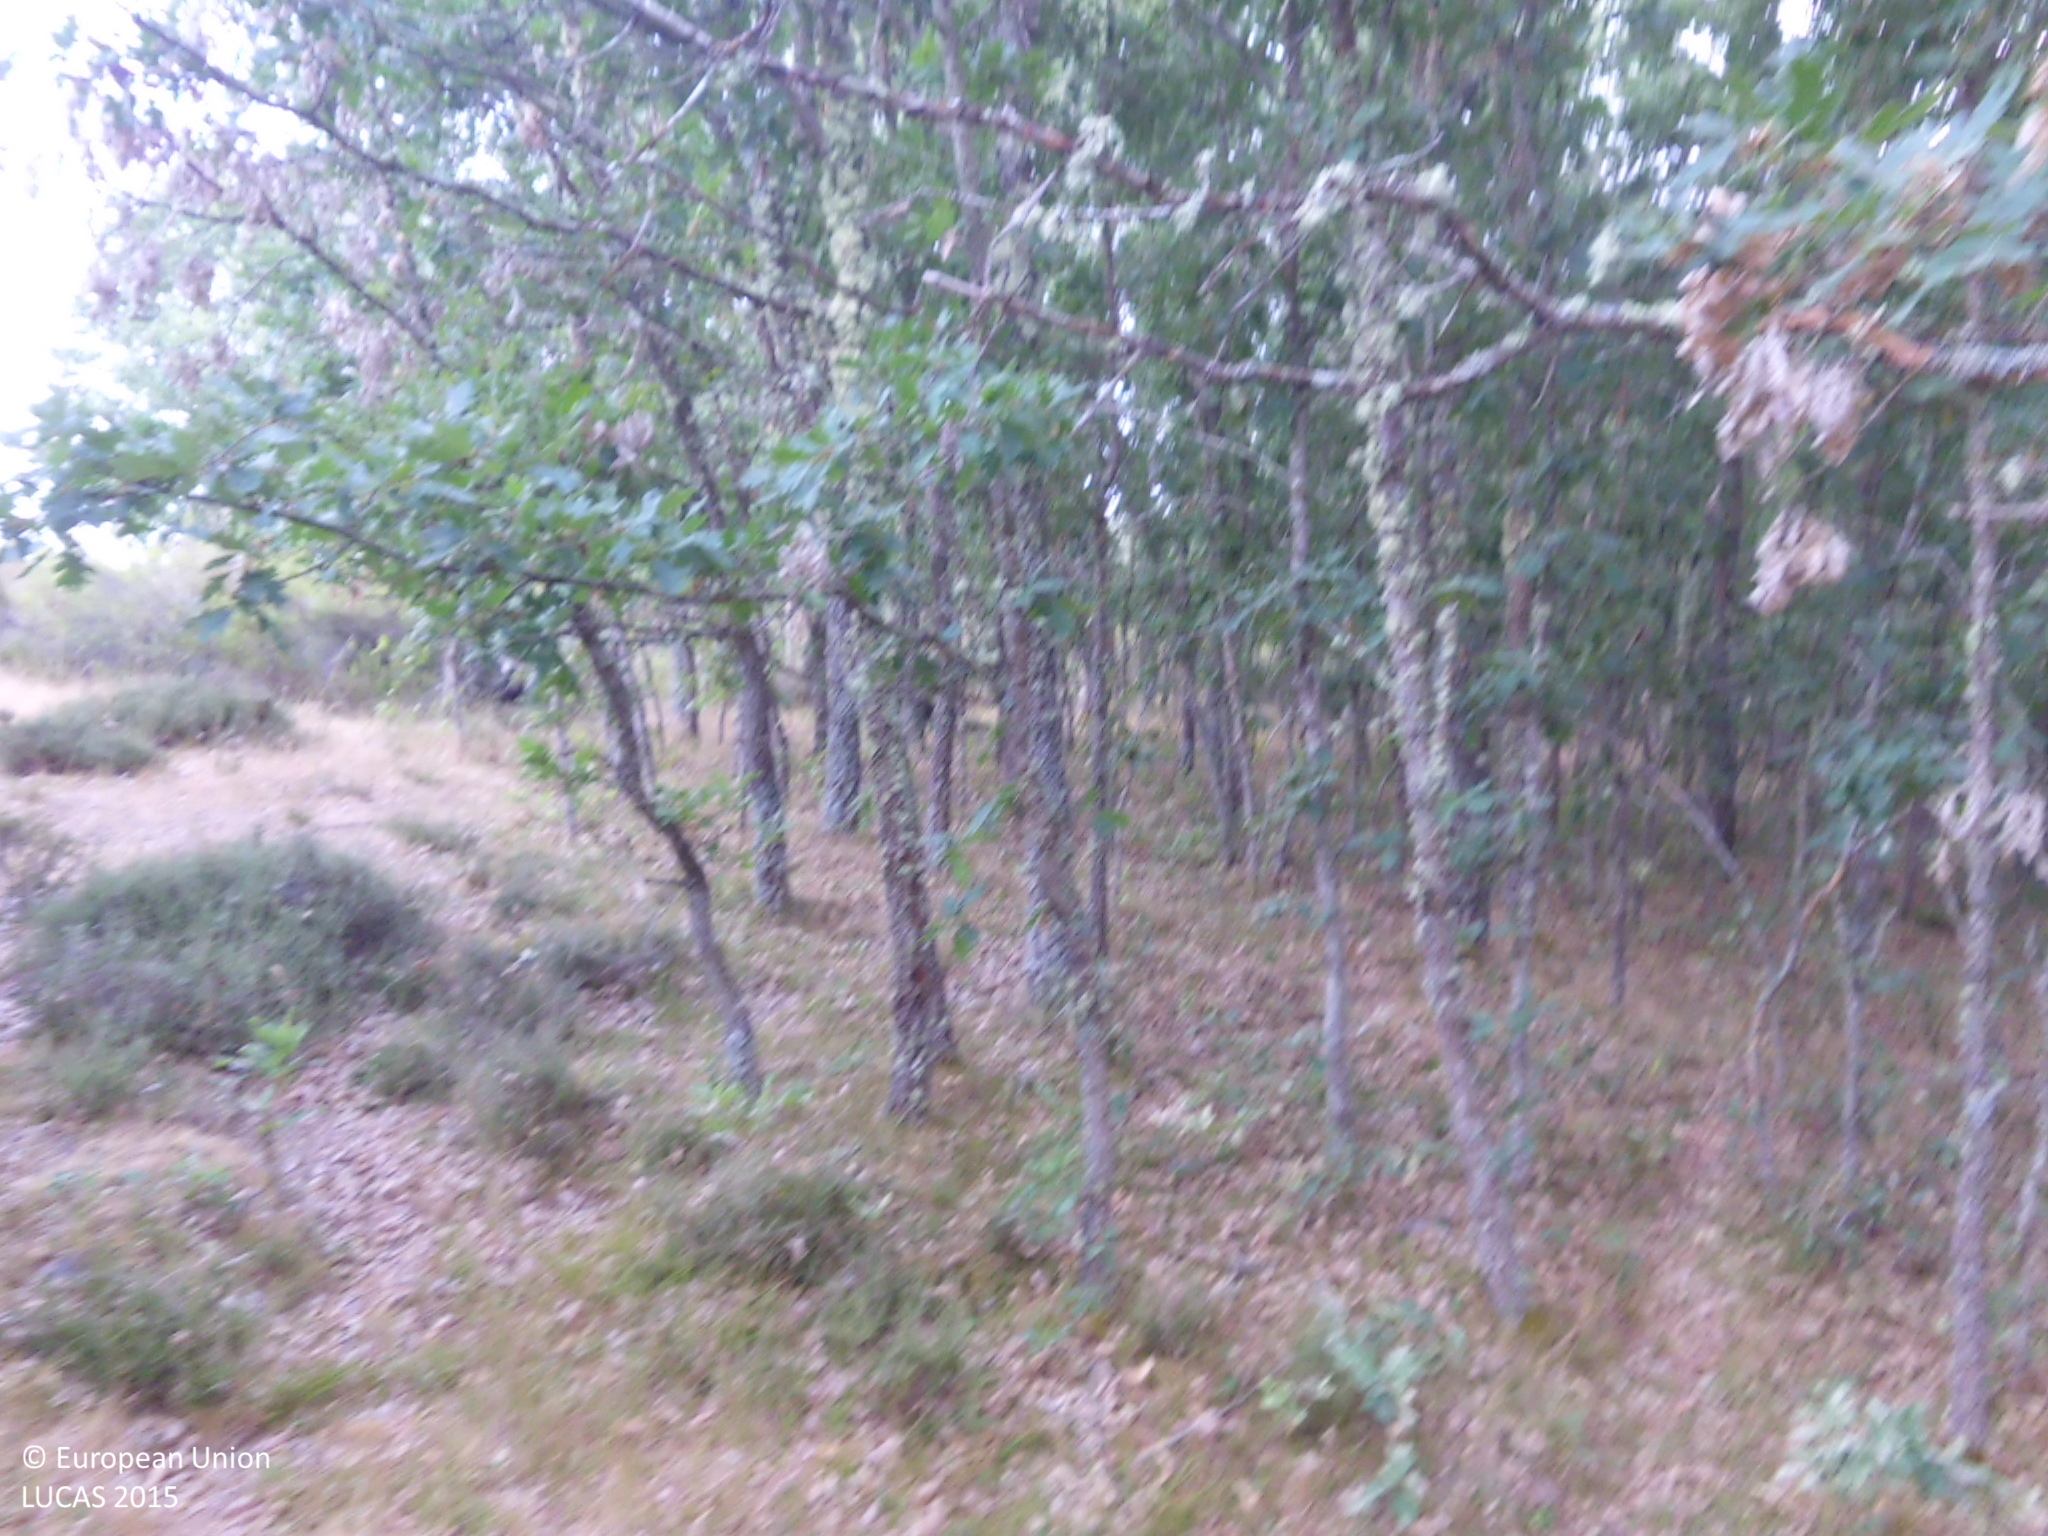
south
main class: Woodland
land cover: Broadleaved woodland
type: acidophilous oak and oak-birch forest
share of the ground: > 75 %
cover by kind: broadleaved forest trees 80 %, shrubs 20 %
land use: Agriculture (excluding fallow land and kitchen gardens)
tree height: > 5 m
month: July
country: ES
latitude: 42.6053
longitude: -4.9183
